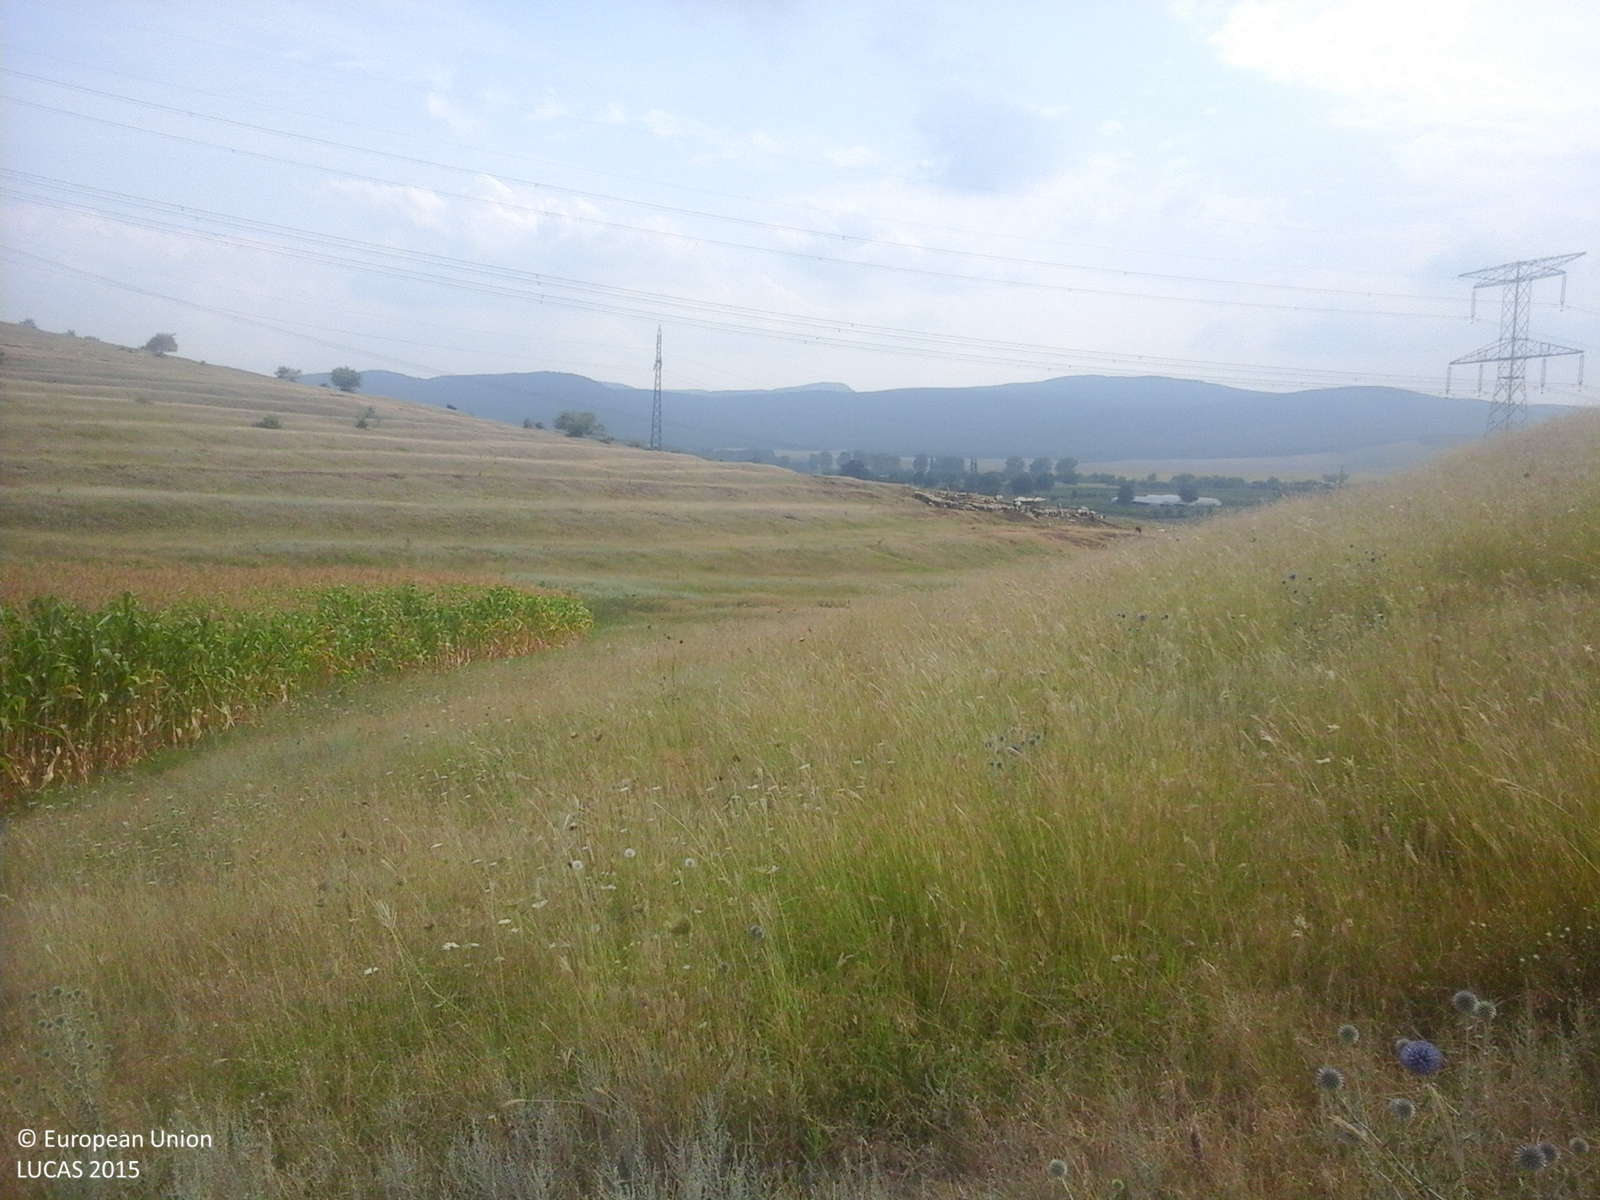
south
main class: Grassland
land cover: Grassland without tree/shrub cover
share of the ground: > 75 %
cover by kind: herbaceous plants 100 %
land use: Agriculture (excluding fallow land and kitchen gardens)
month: July
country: RO
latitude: 45.2735
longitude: 28.2887
